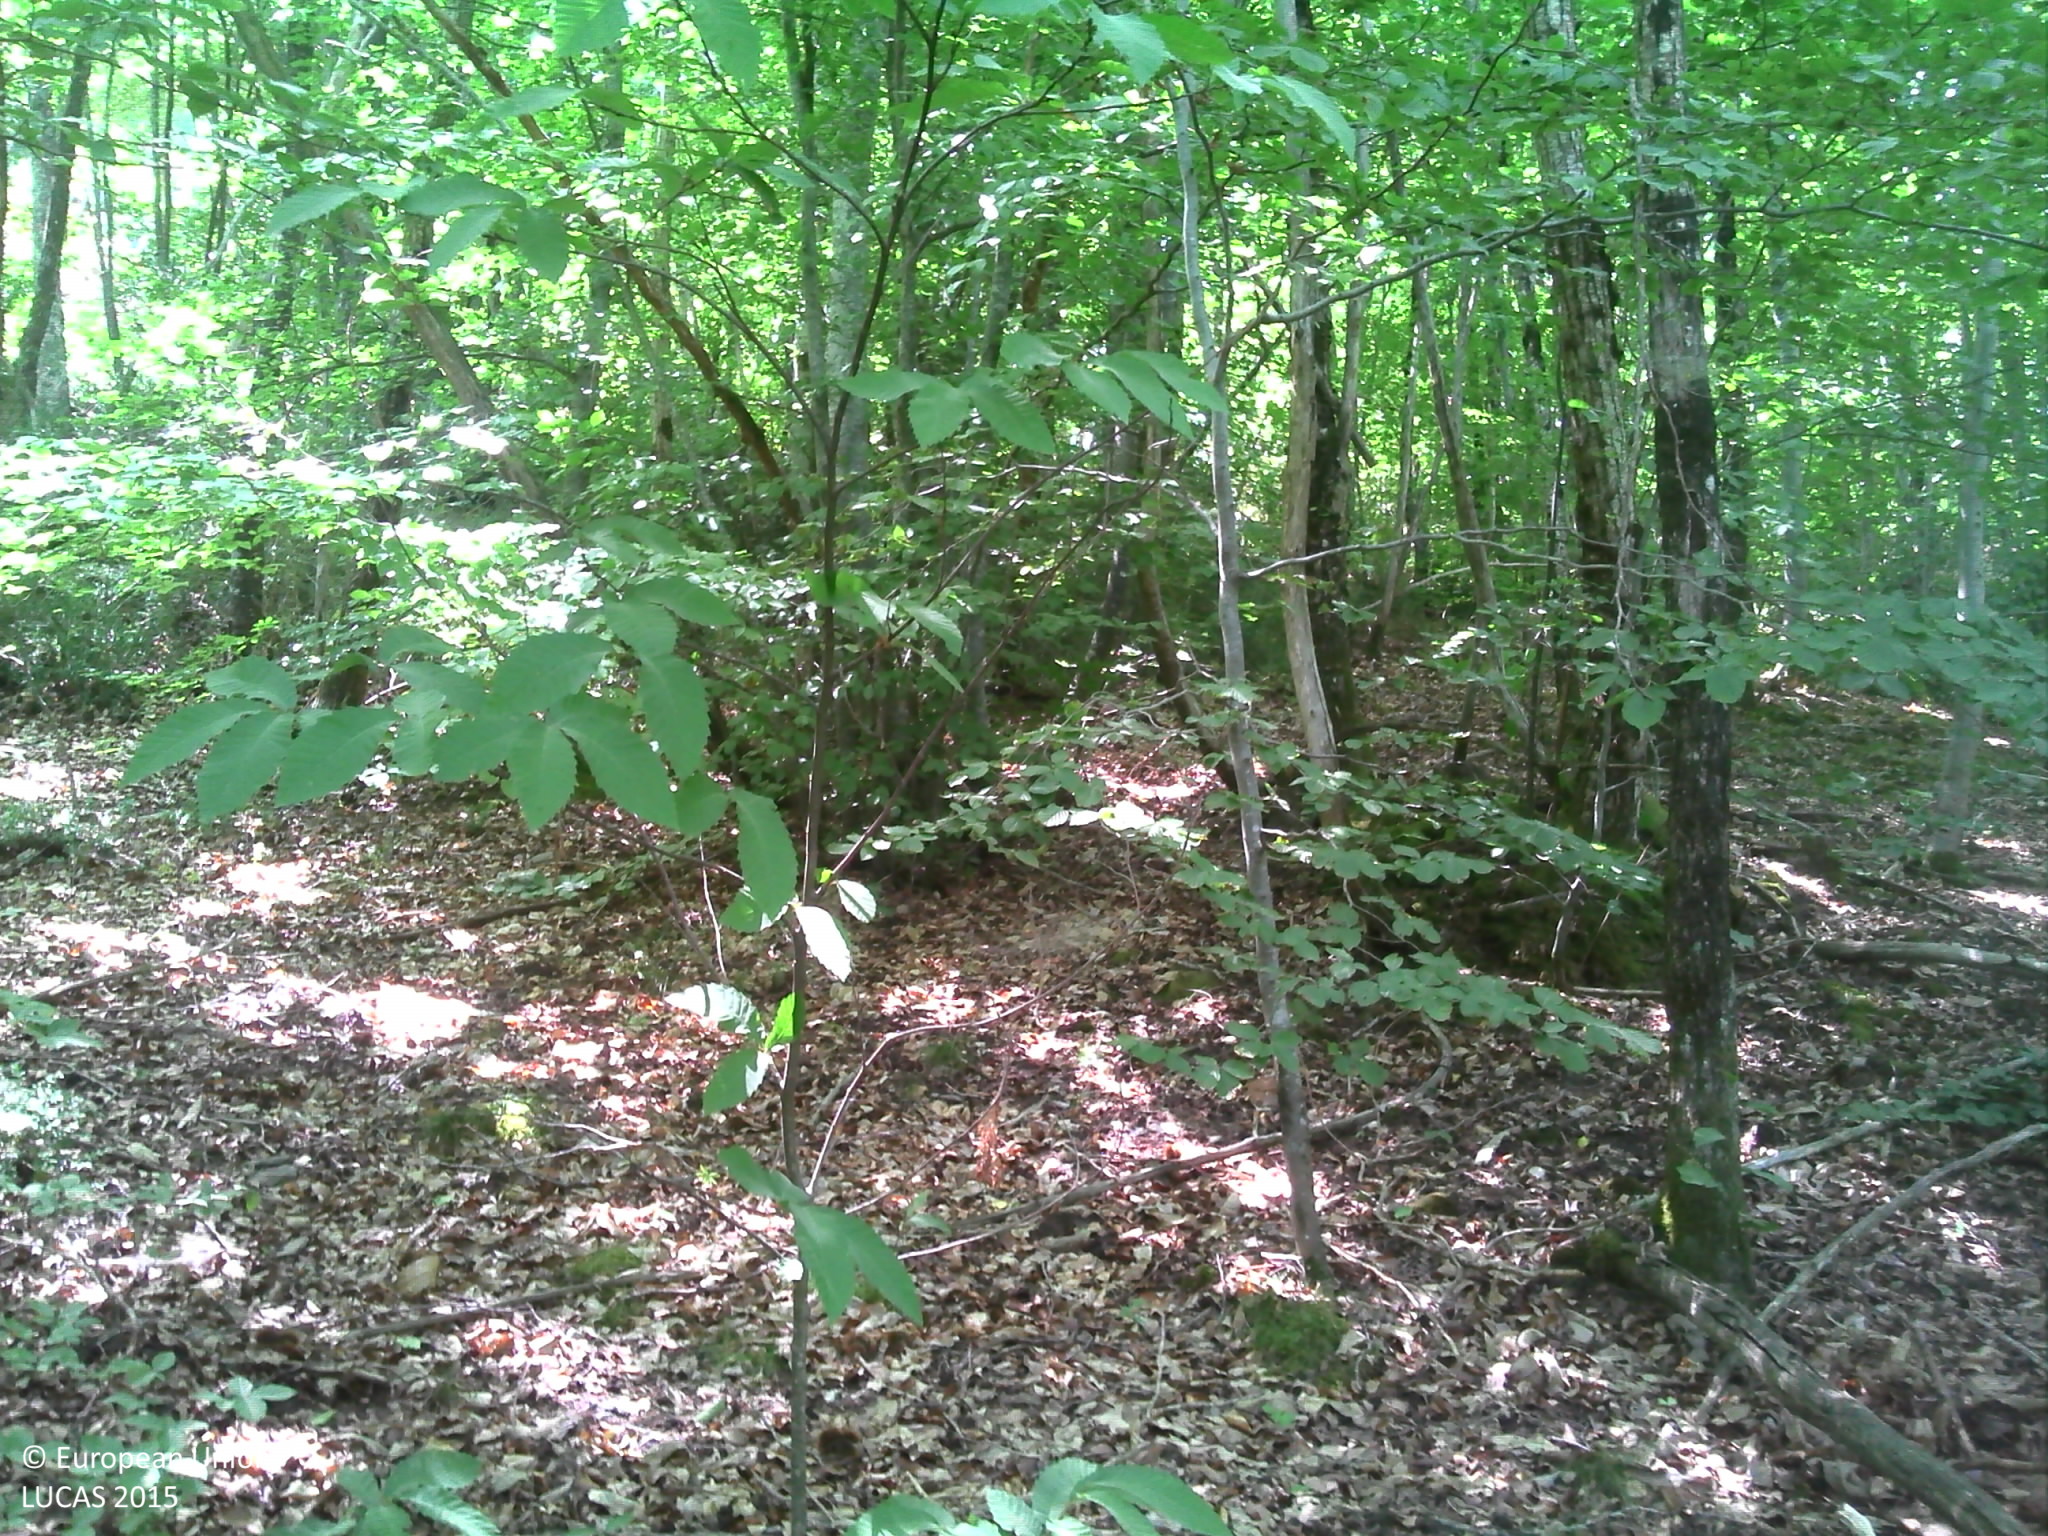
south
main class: Woodland
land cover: Broadleaved woodland
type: beech forest
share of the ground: > 75 %
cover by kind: broadleaved forest trees 85 %, unconsolidated bare surface 10 %, coniferous forest trees 5 %
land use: Forestry
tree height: > 5 m
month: July
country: FR
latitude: 44.2228
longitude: 3.5597
